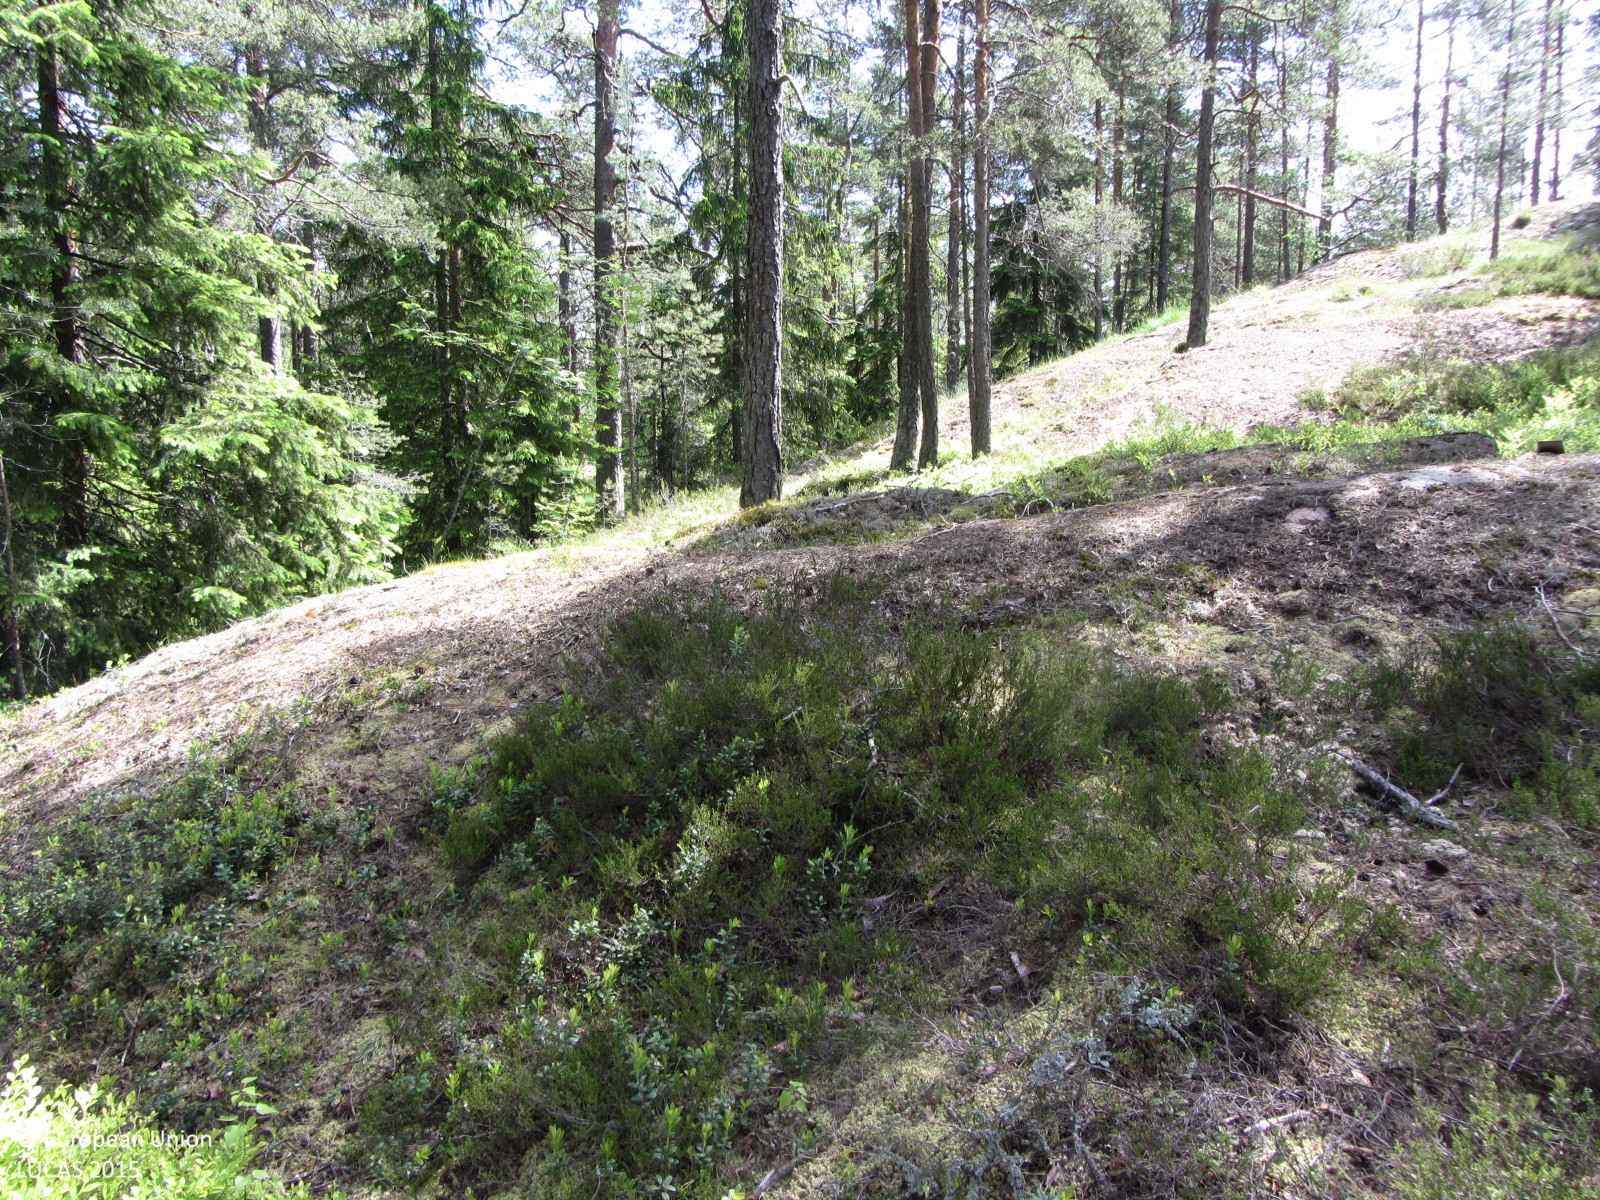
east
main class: Woodland
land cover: Pine dominated coniferous woodland
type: boreal forest
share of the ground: > 75 %
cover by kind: coniferous forest trees 70 %, shrubs 10 %, consolidated bare surface 10 %, broadleaved forest trees 5 %, lichens and mosses 5 %
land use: Forestry
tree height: > 5 m
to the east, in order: Pine dominated coniferous woodland; Spruce dominated coniferous woodland; Shrubland with sparse tree cover; Tracks; Spruce dominated coniferous woodland; Tracks; Pine dominated coniferous woodland; Pine dominated mixed woodland
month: June
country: FI
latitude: 60.1658
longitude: 24.6177
